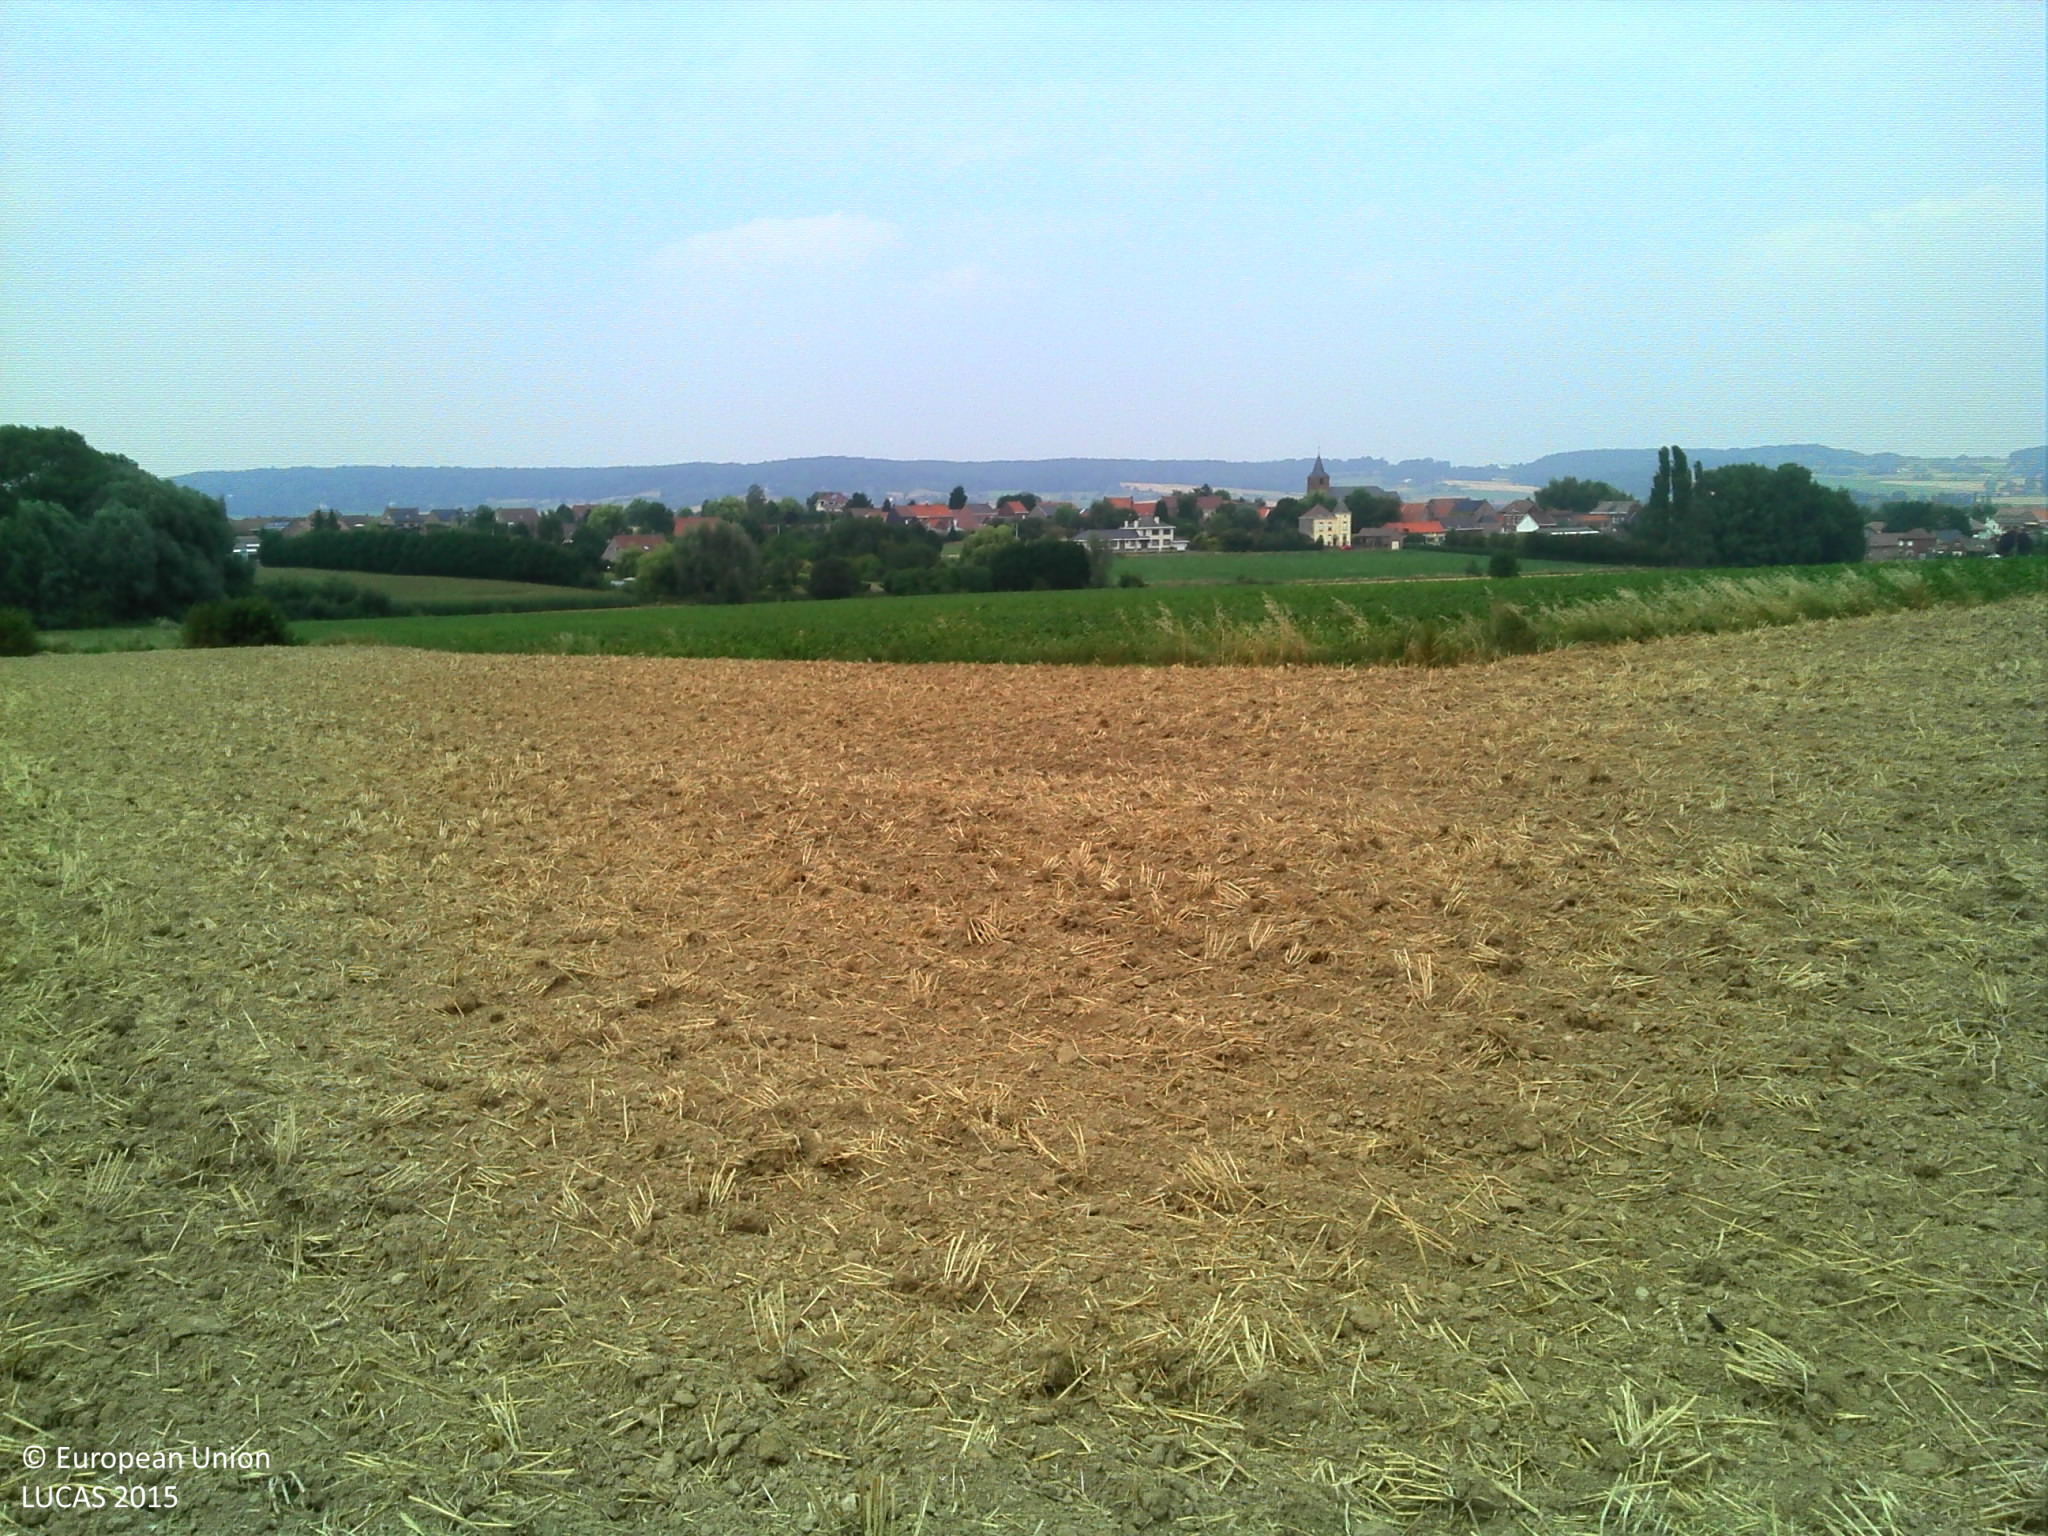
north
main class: Cropland
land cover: Common wheat
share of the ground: > 75 %
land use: Agriculture (excluding fallow land and kitchen gardens)
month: August
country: BE
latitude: 50.7214
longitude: 3.5190
